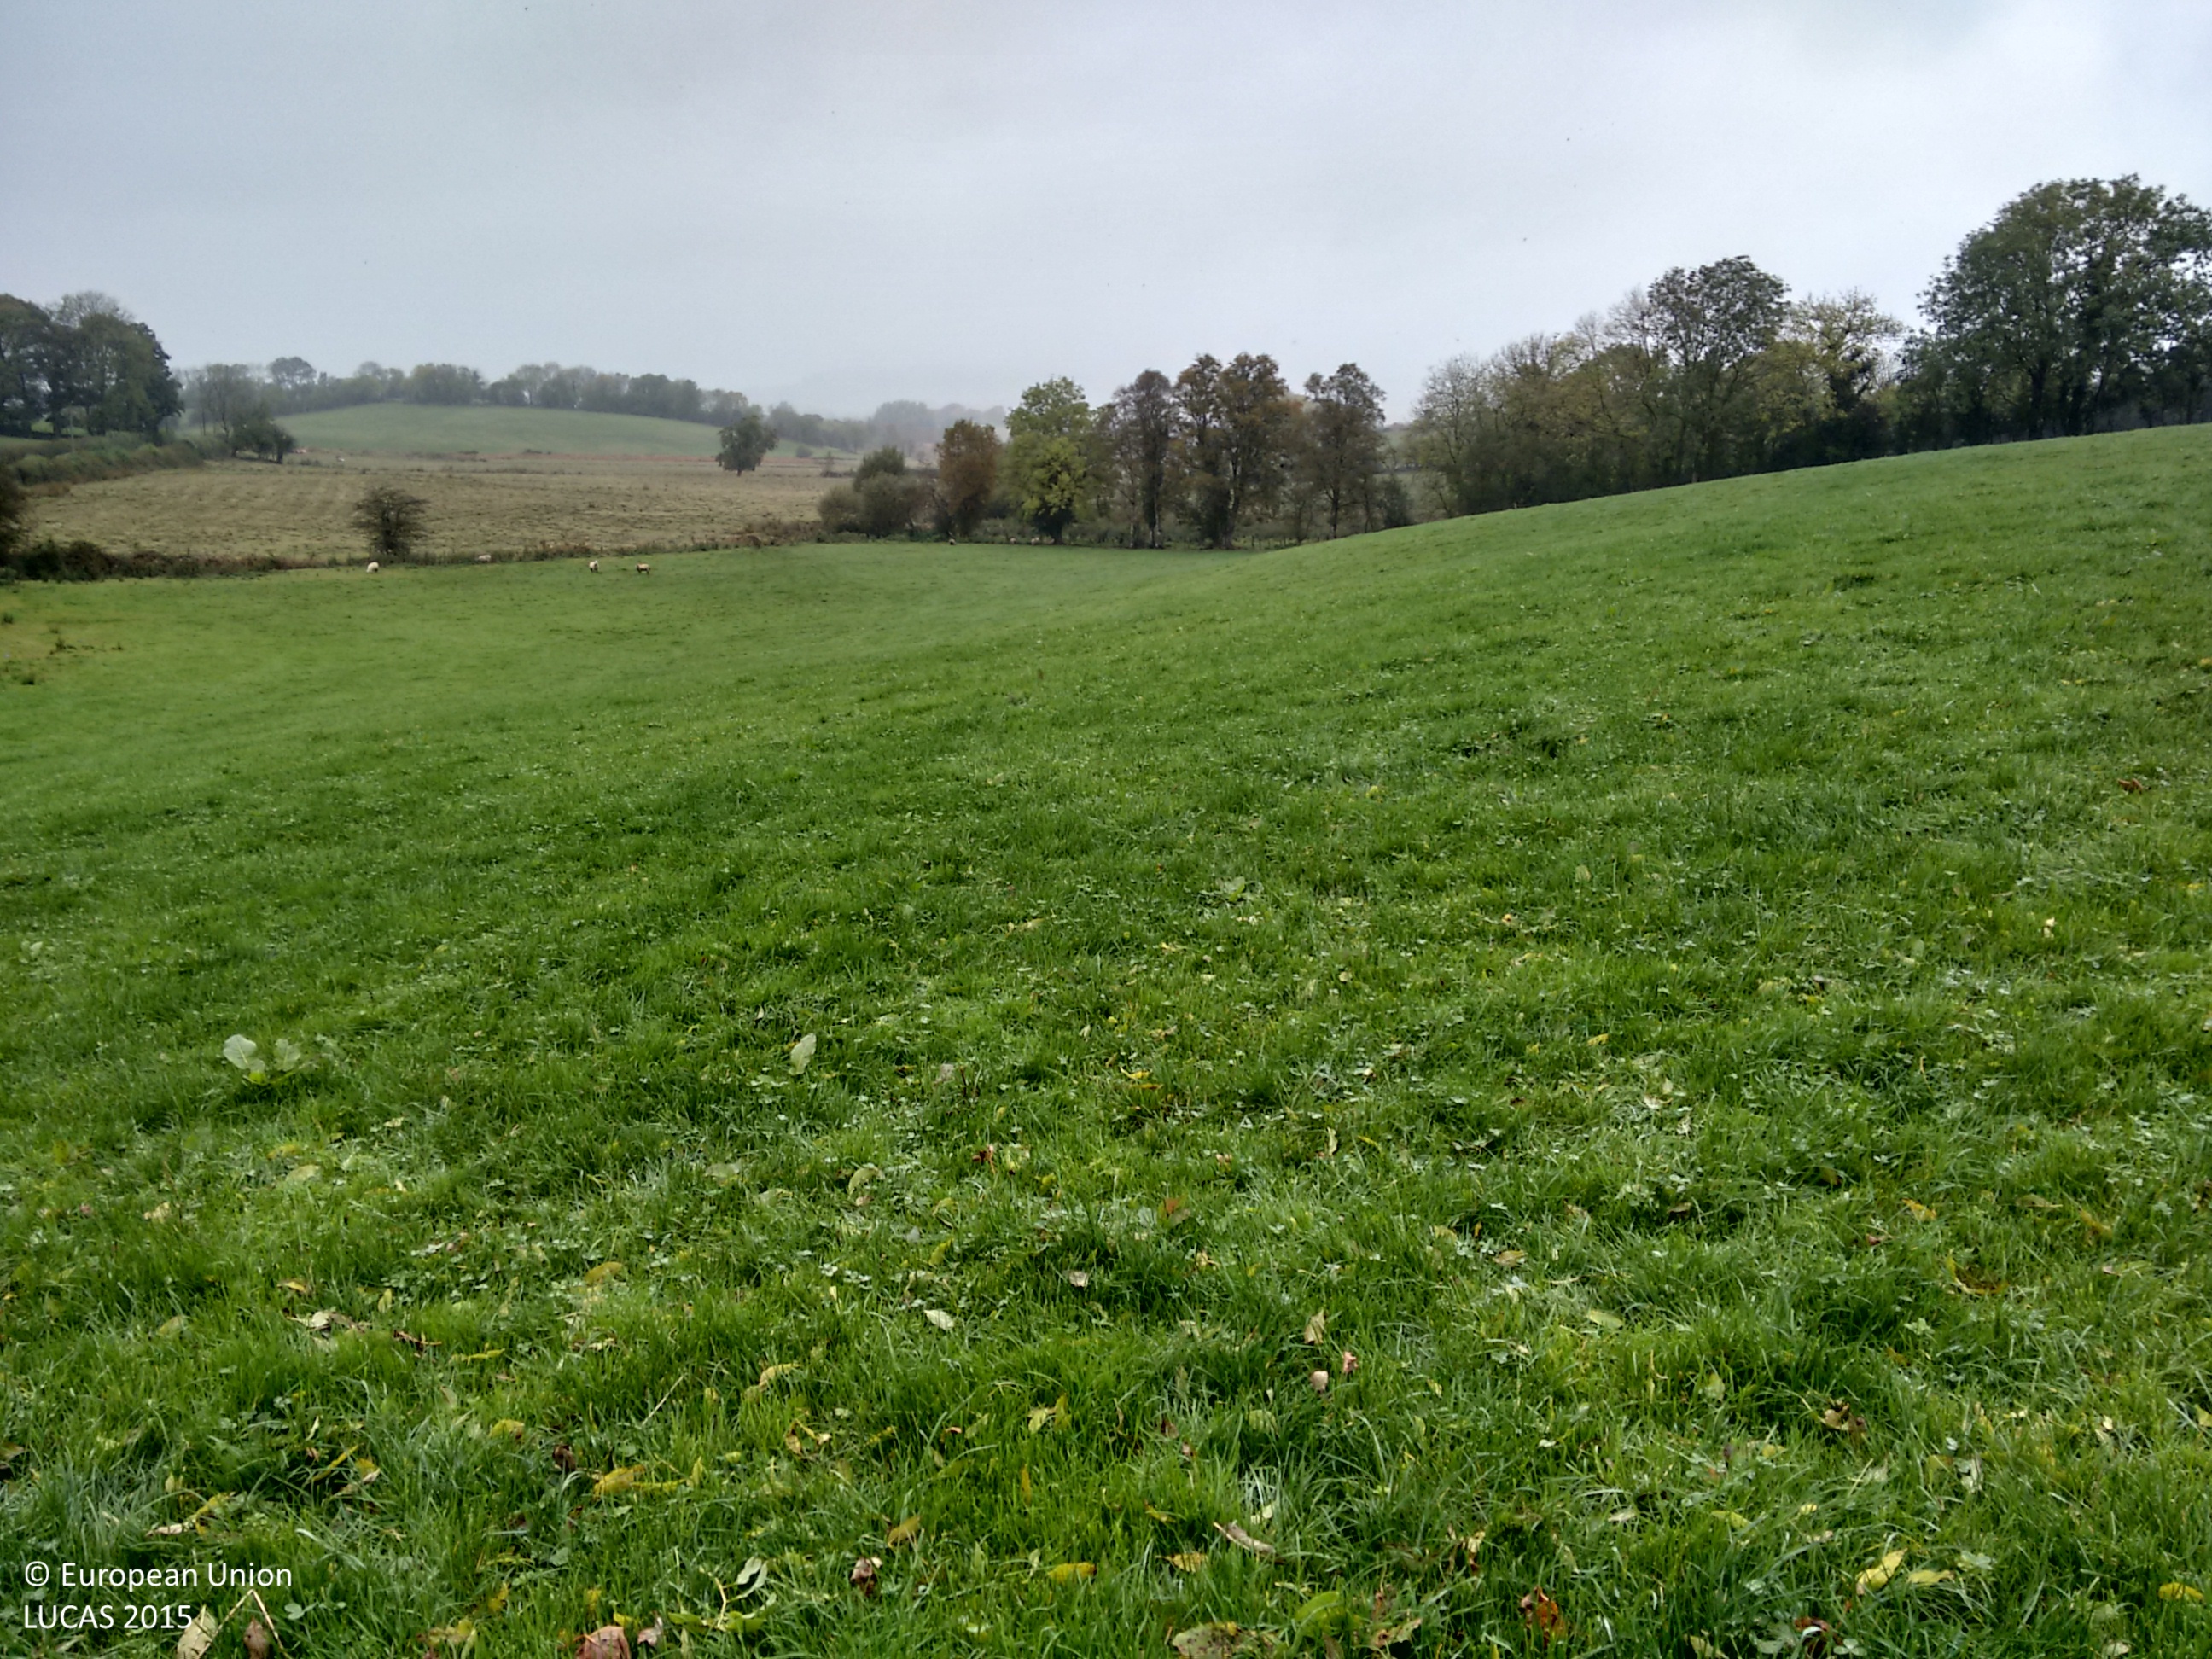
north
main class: Grassland
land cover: Grassland without tree/shrub cover
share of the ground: > 75 %
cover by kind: herbaceous plants 100 %
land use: Agriculture (excluding fallow land and kitchen gardens)
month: October
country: GB
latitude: 54.6393
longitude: -7.4931
